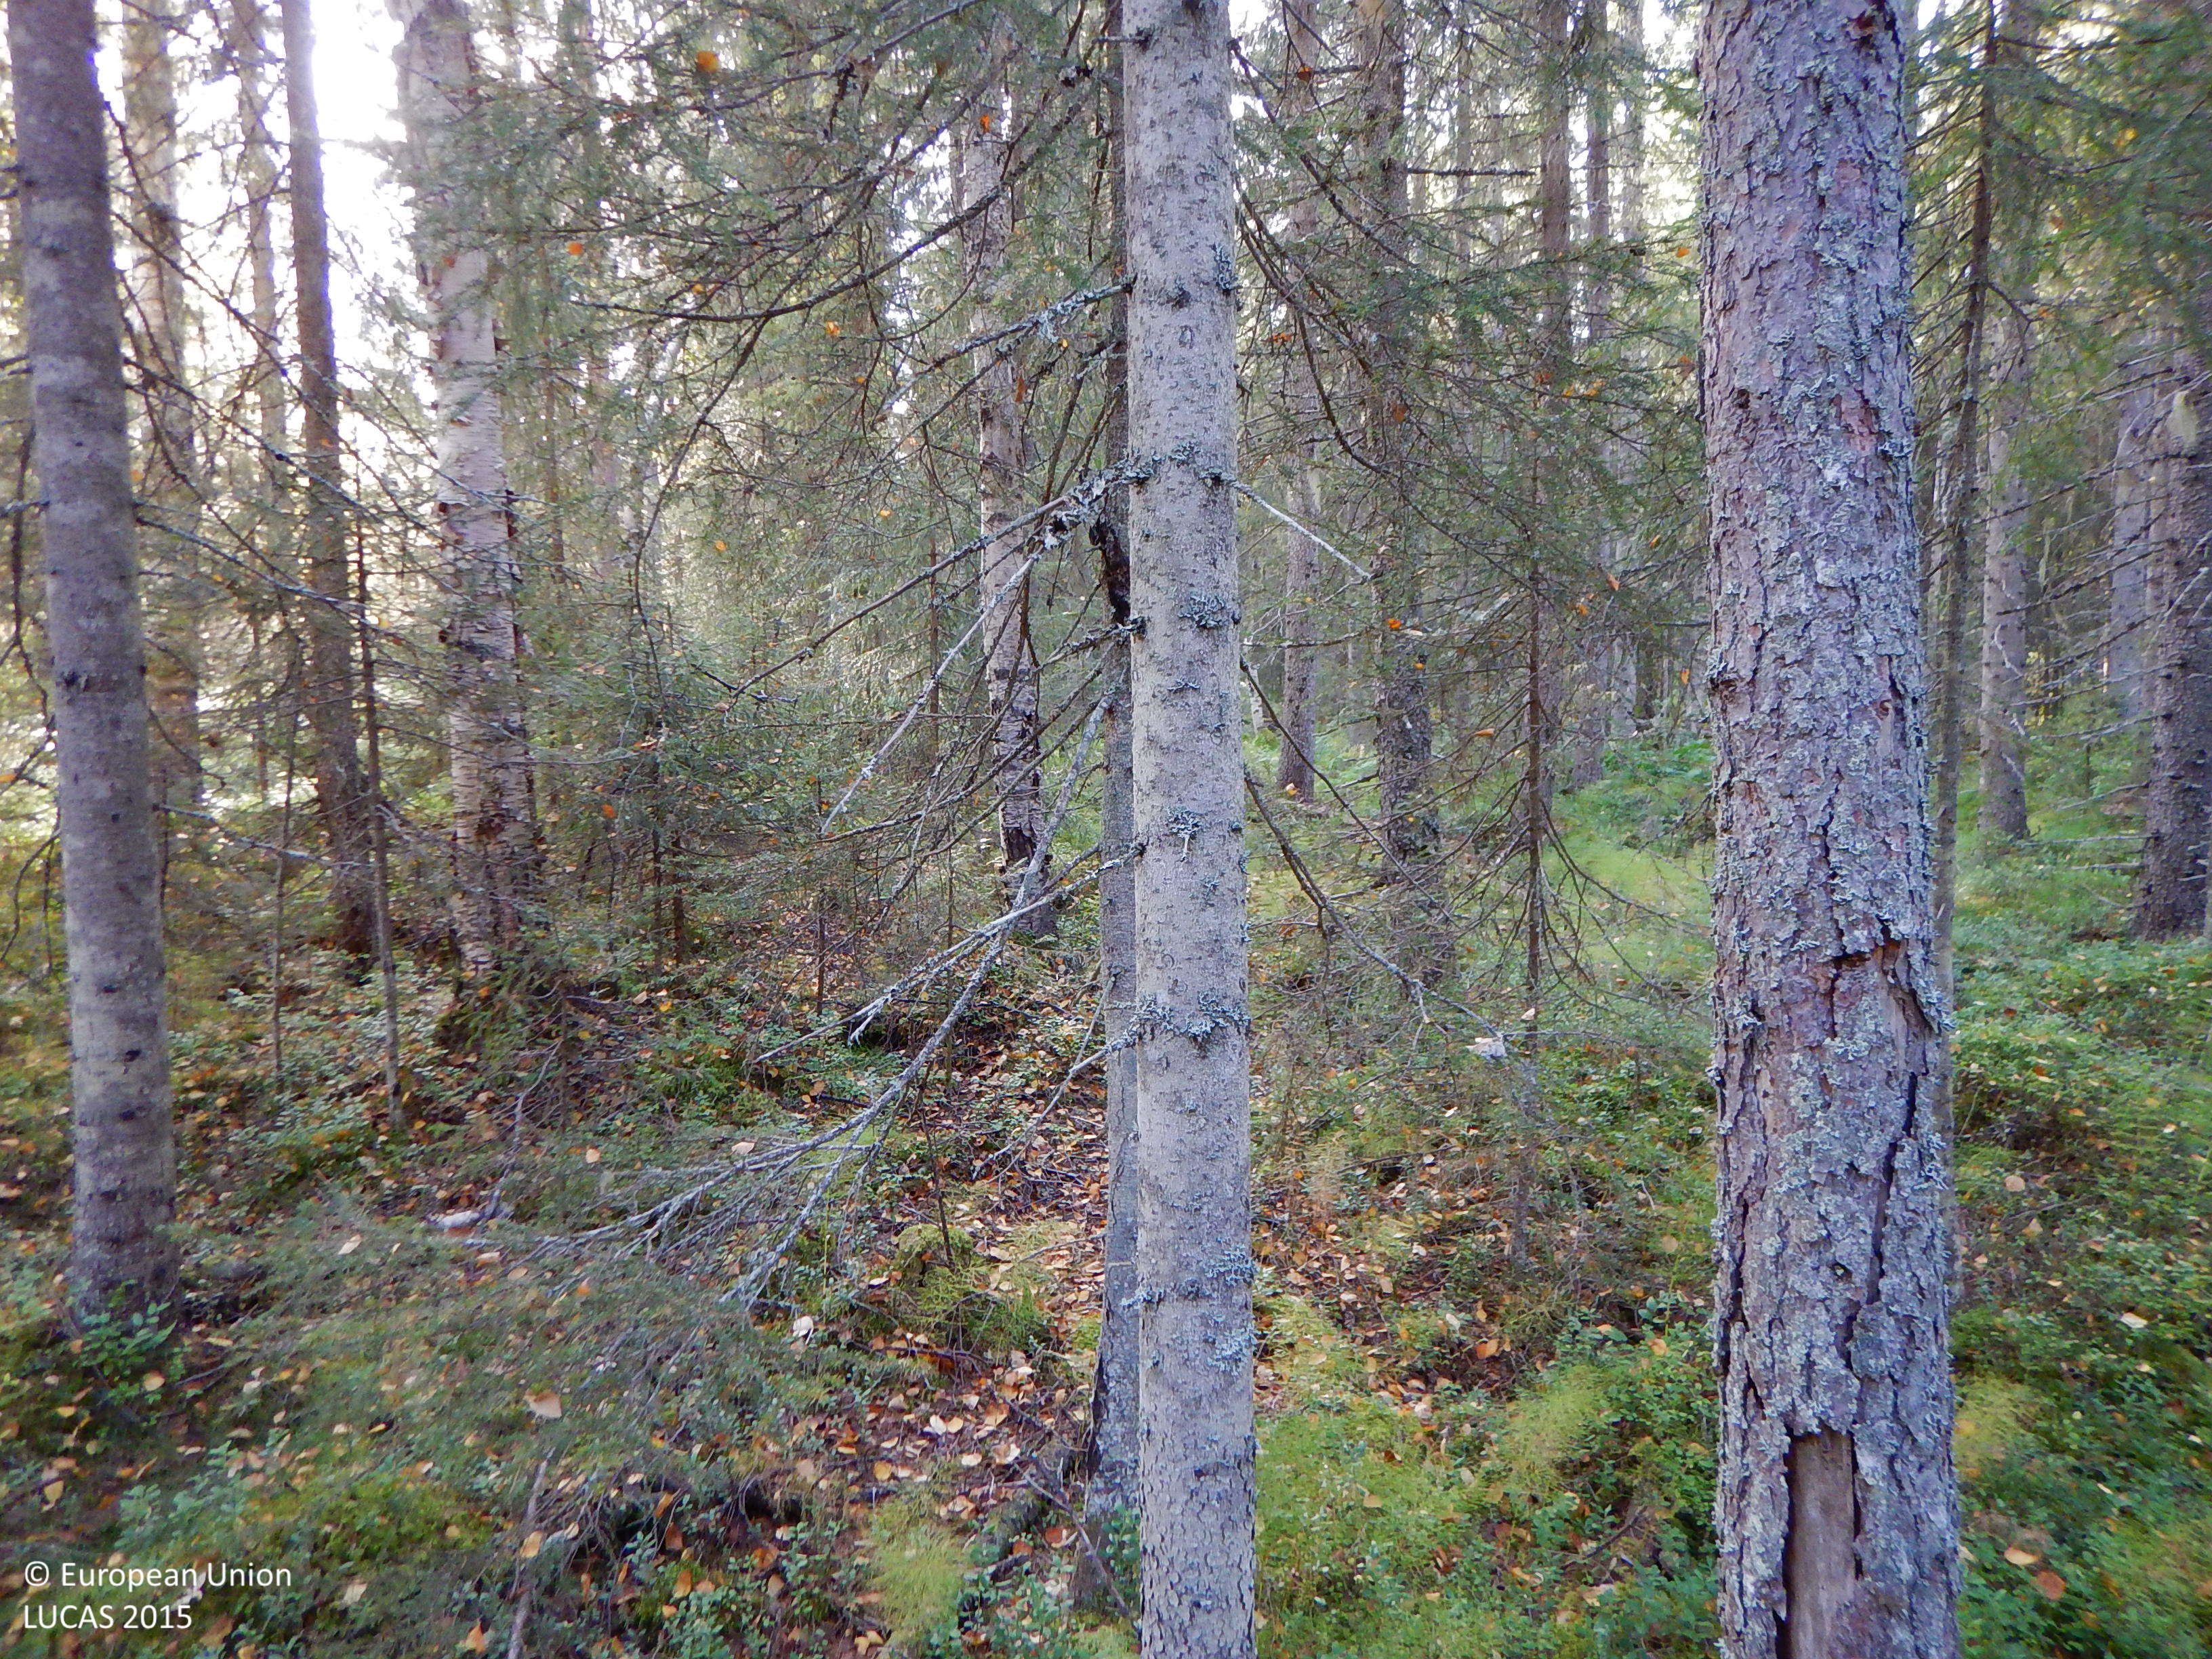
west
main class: Woodland
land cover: Spruce dominated coniferous woodland
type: boreal forest
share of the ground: 50 - 75 %
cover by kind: coniferous forest trees 50 %, shrubs 15 %, lichens and mosses 15 %, broadleaved forest trees 10 %, herbaceous plants 10 %
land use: Forestry
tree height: > 5 m
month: September
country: SE
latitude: 64.6955
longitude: 20.1005
